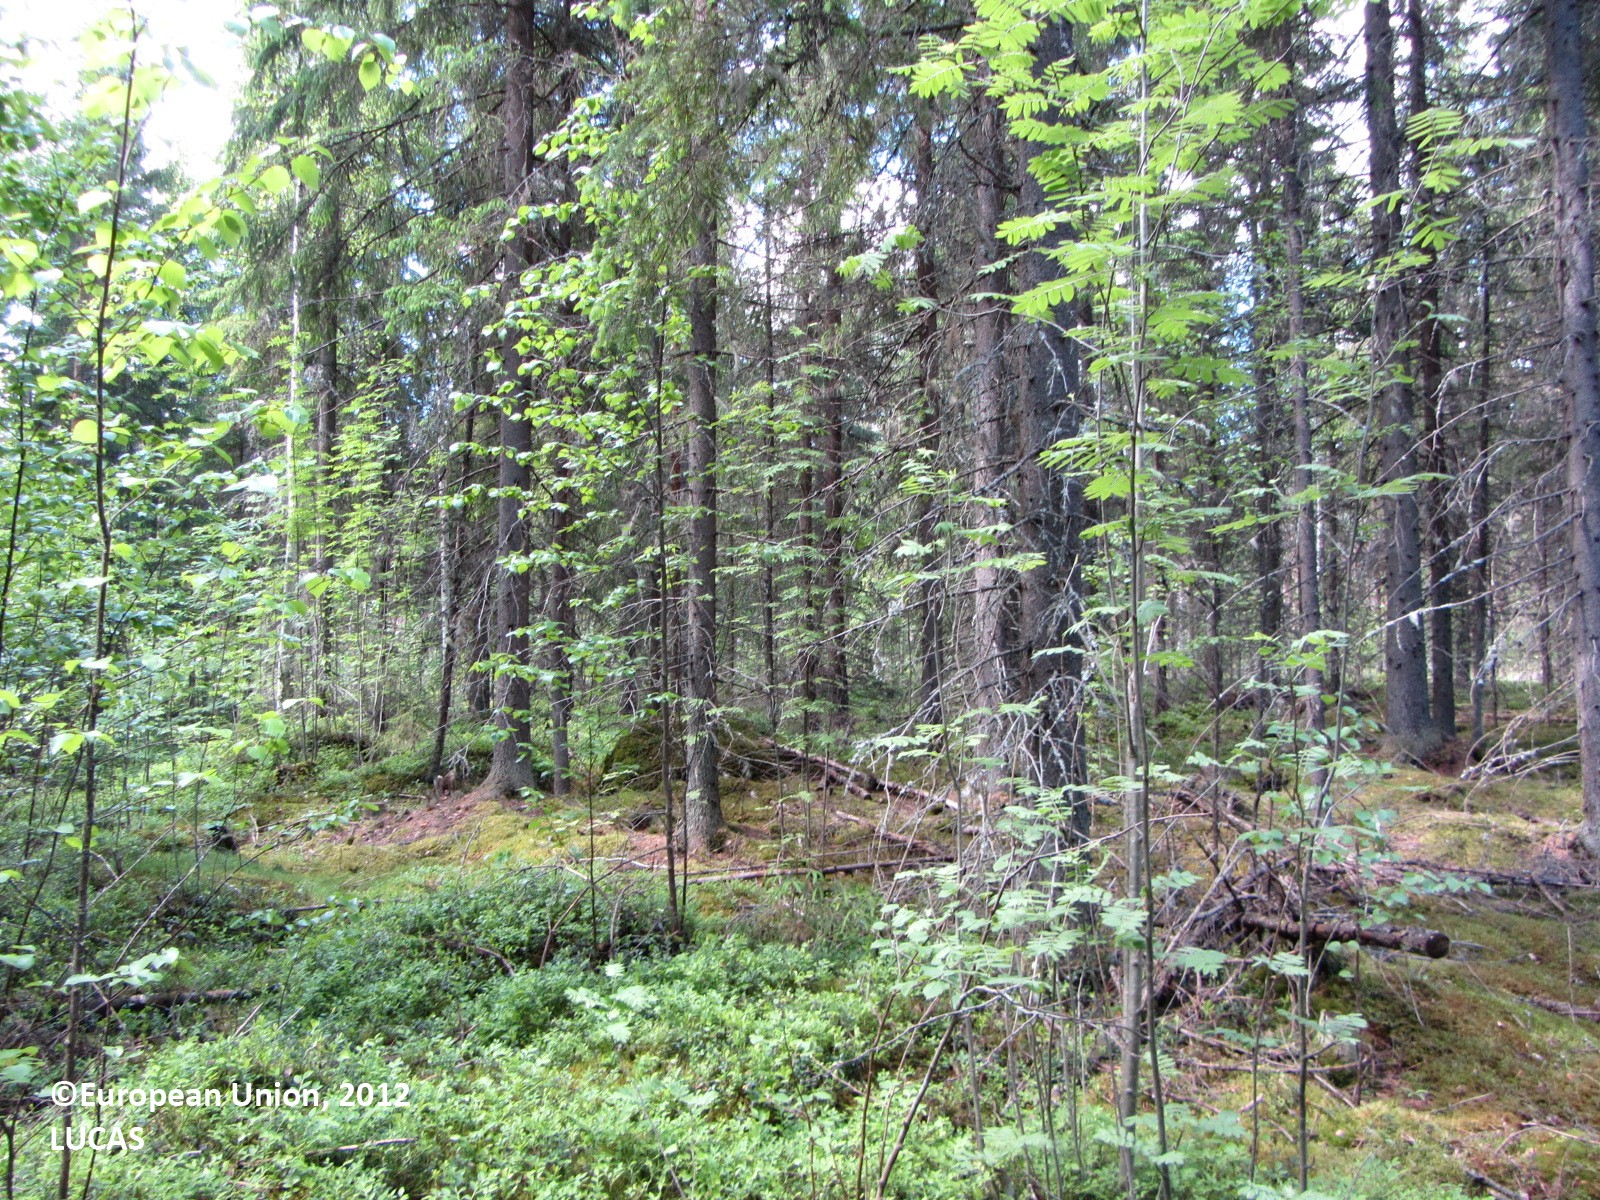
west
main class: Woodland
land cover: Spruce dominated mixed woodland
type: boreal forest
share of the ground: 50 - 75 %
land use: Forestry
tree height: > 5 m
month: June
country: FI
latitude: 62.0253
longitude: 24.9519
